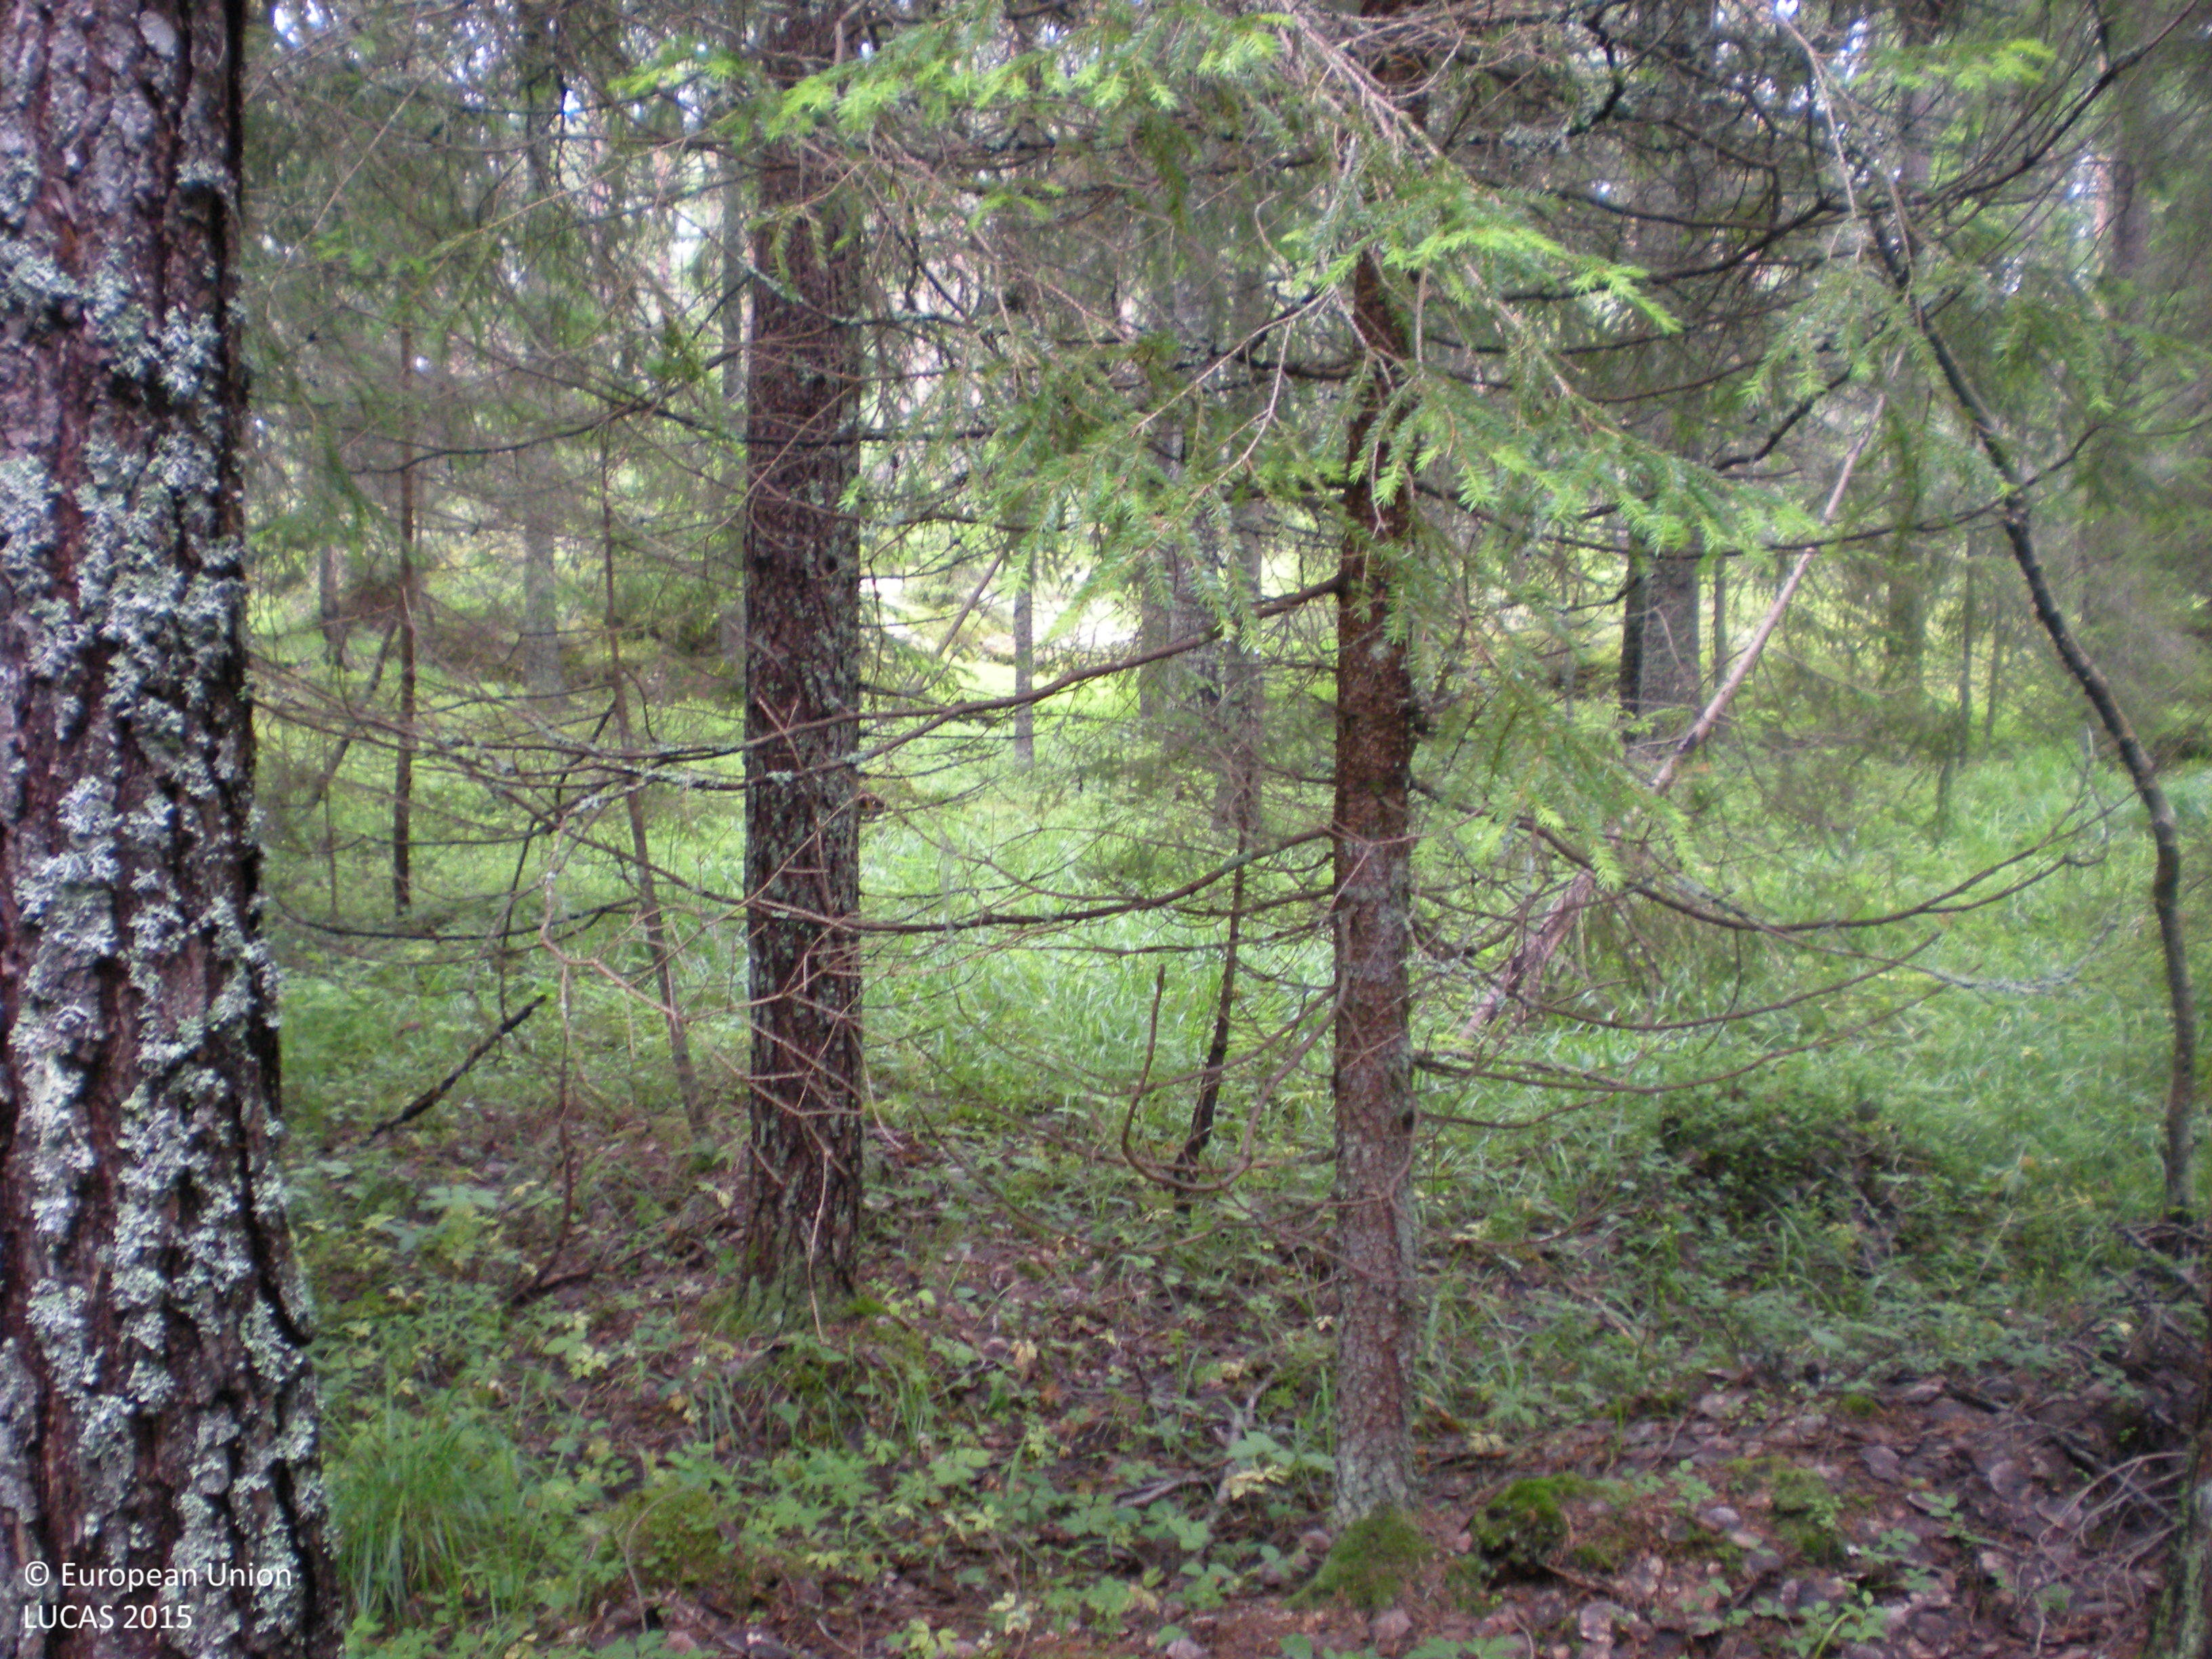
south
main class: Woodland
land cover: Other coniferous woodland
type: boreal forest
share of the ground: > 75 %
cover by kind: coniferous forest trees 55 %, broadleaved forest trees 15 %, herbaceous plants 15 %, shrubs 5 %, lichens and mosses 5 %
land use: Forestry
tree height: > 5 m
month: June
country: SE
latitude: 60.3983
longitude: 17.8146
